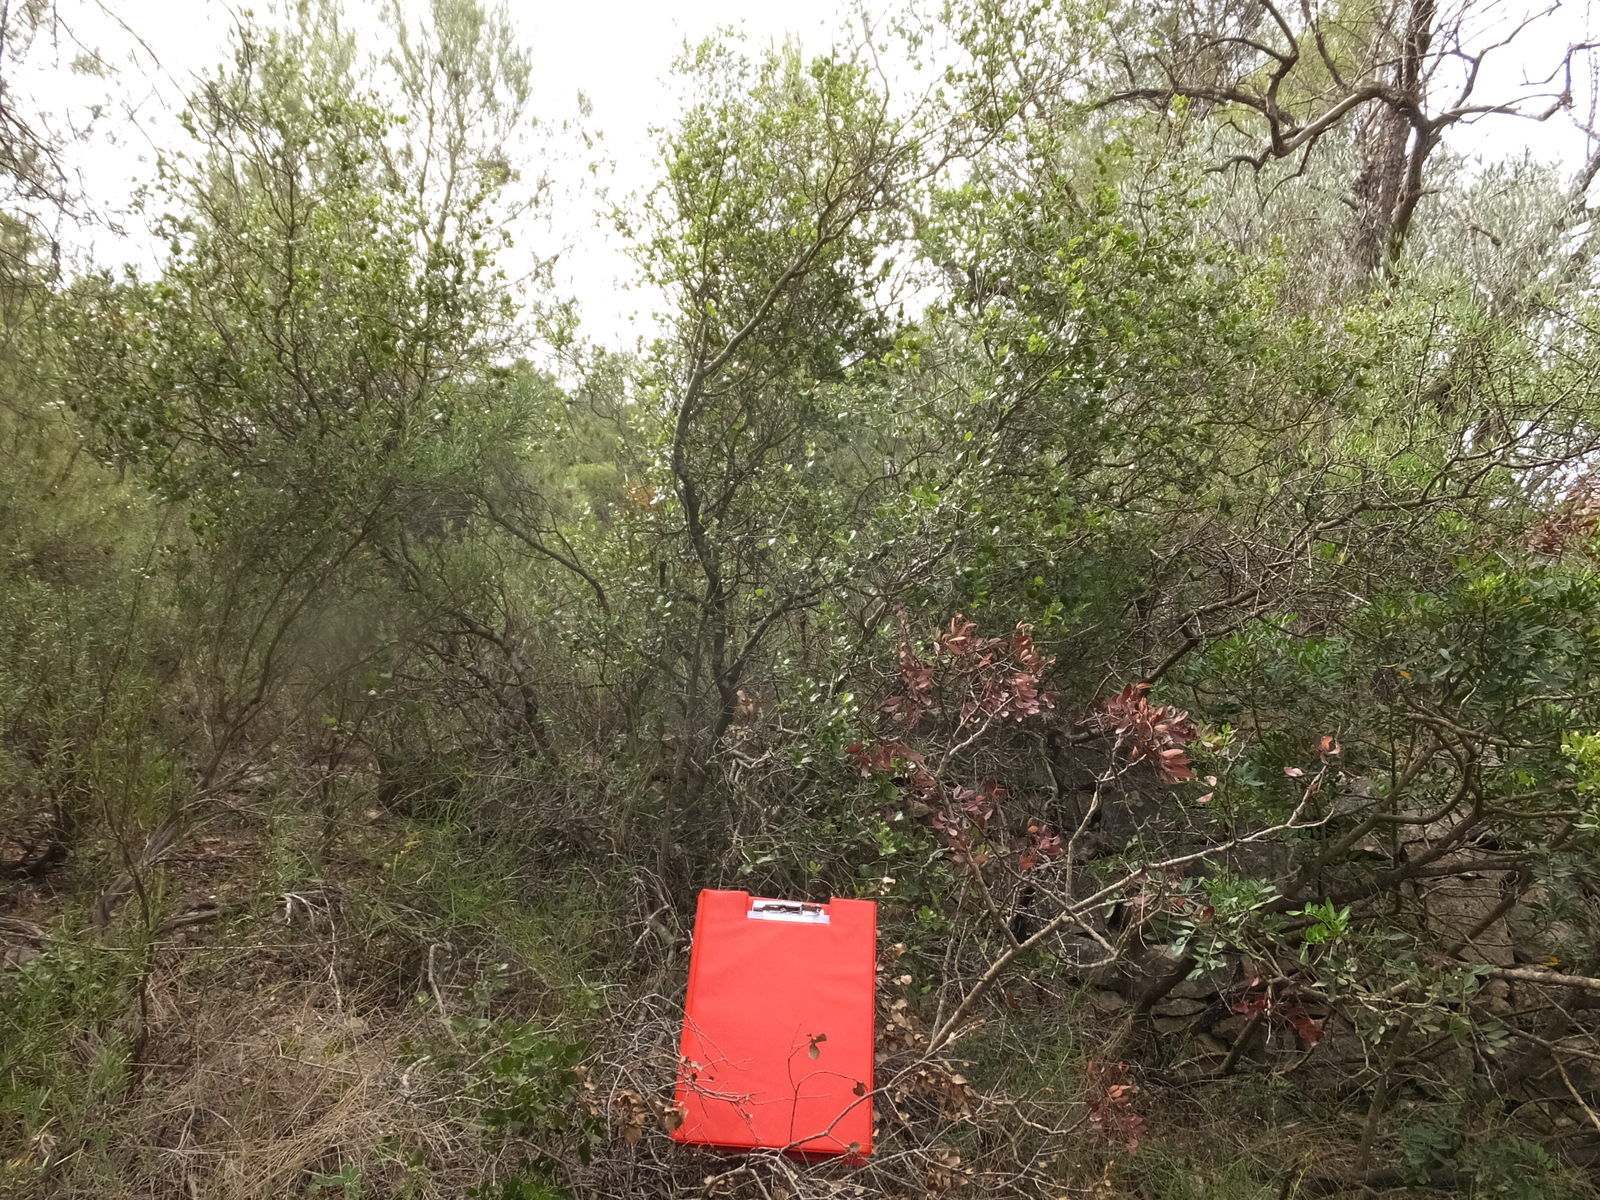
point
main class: Woodland
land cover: Pine dominated mixed woodland
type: coniferous forest of the mediterranean region
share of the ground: 50 - 75 %
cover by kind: coniferous forest trees 60 %, broadleaved forest trees 20 %, shrubs 20 %
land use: Forestry
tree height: > 5 m
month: July
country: ES
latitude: 41.3730
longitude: 0.3397
